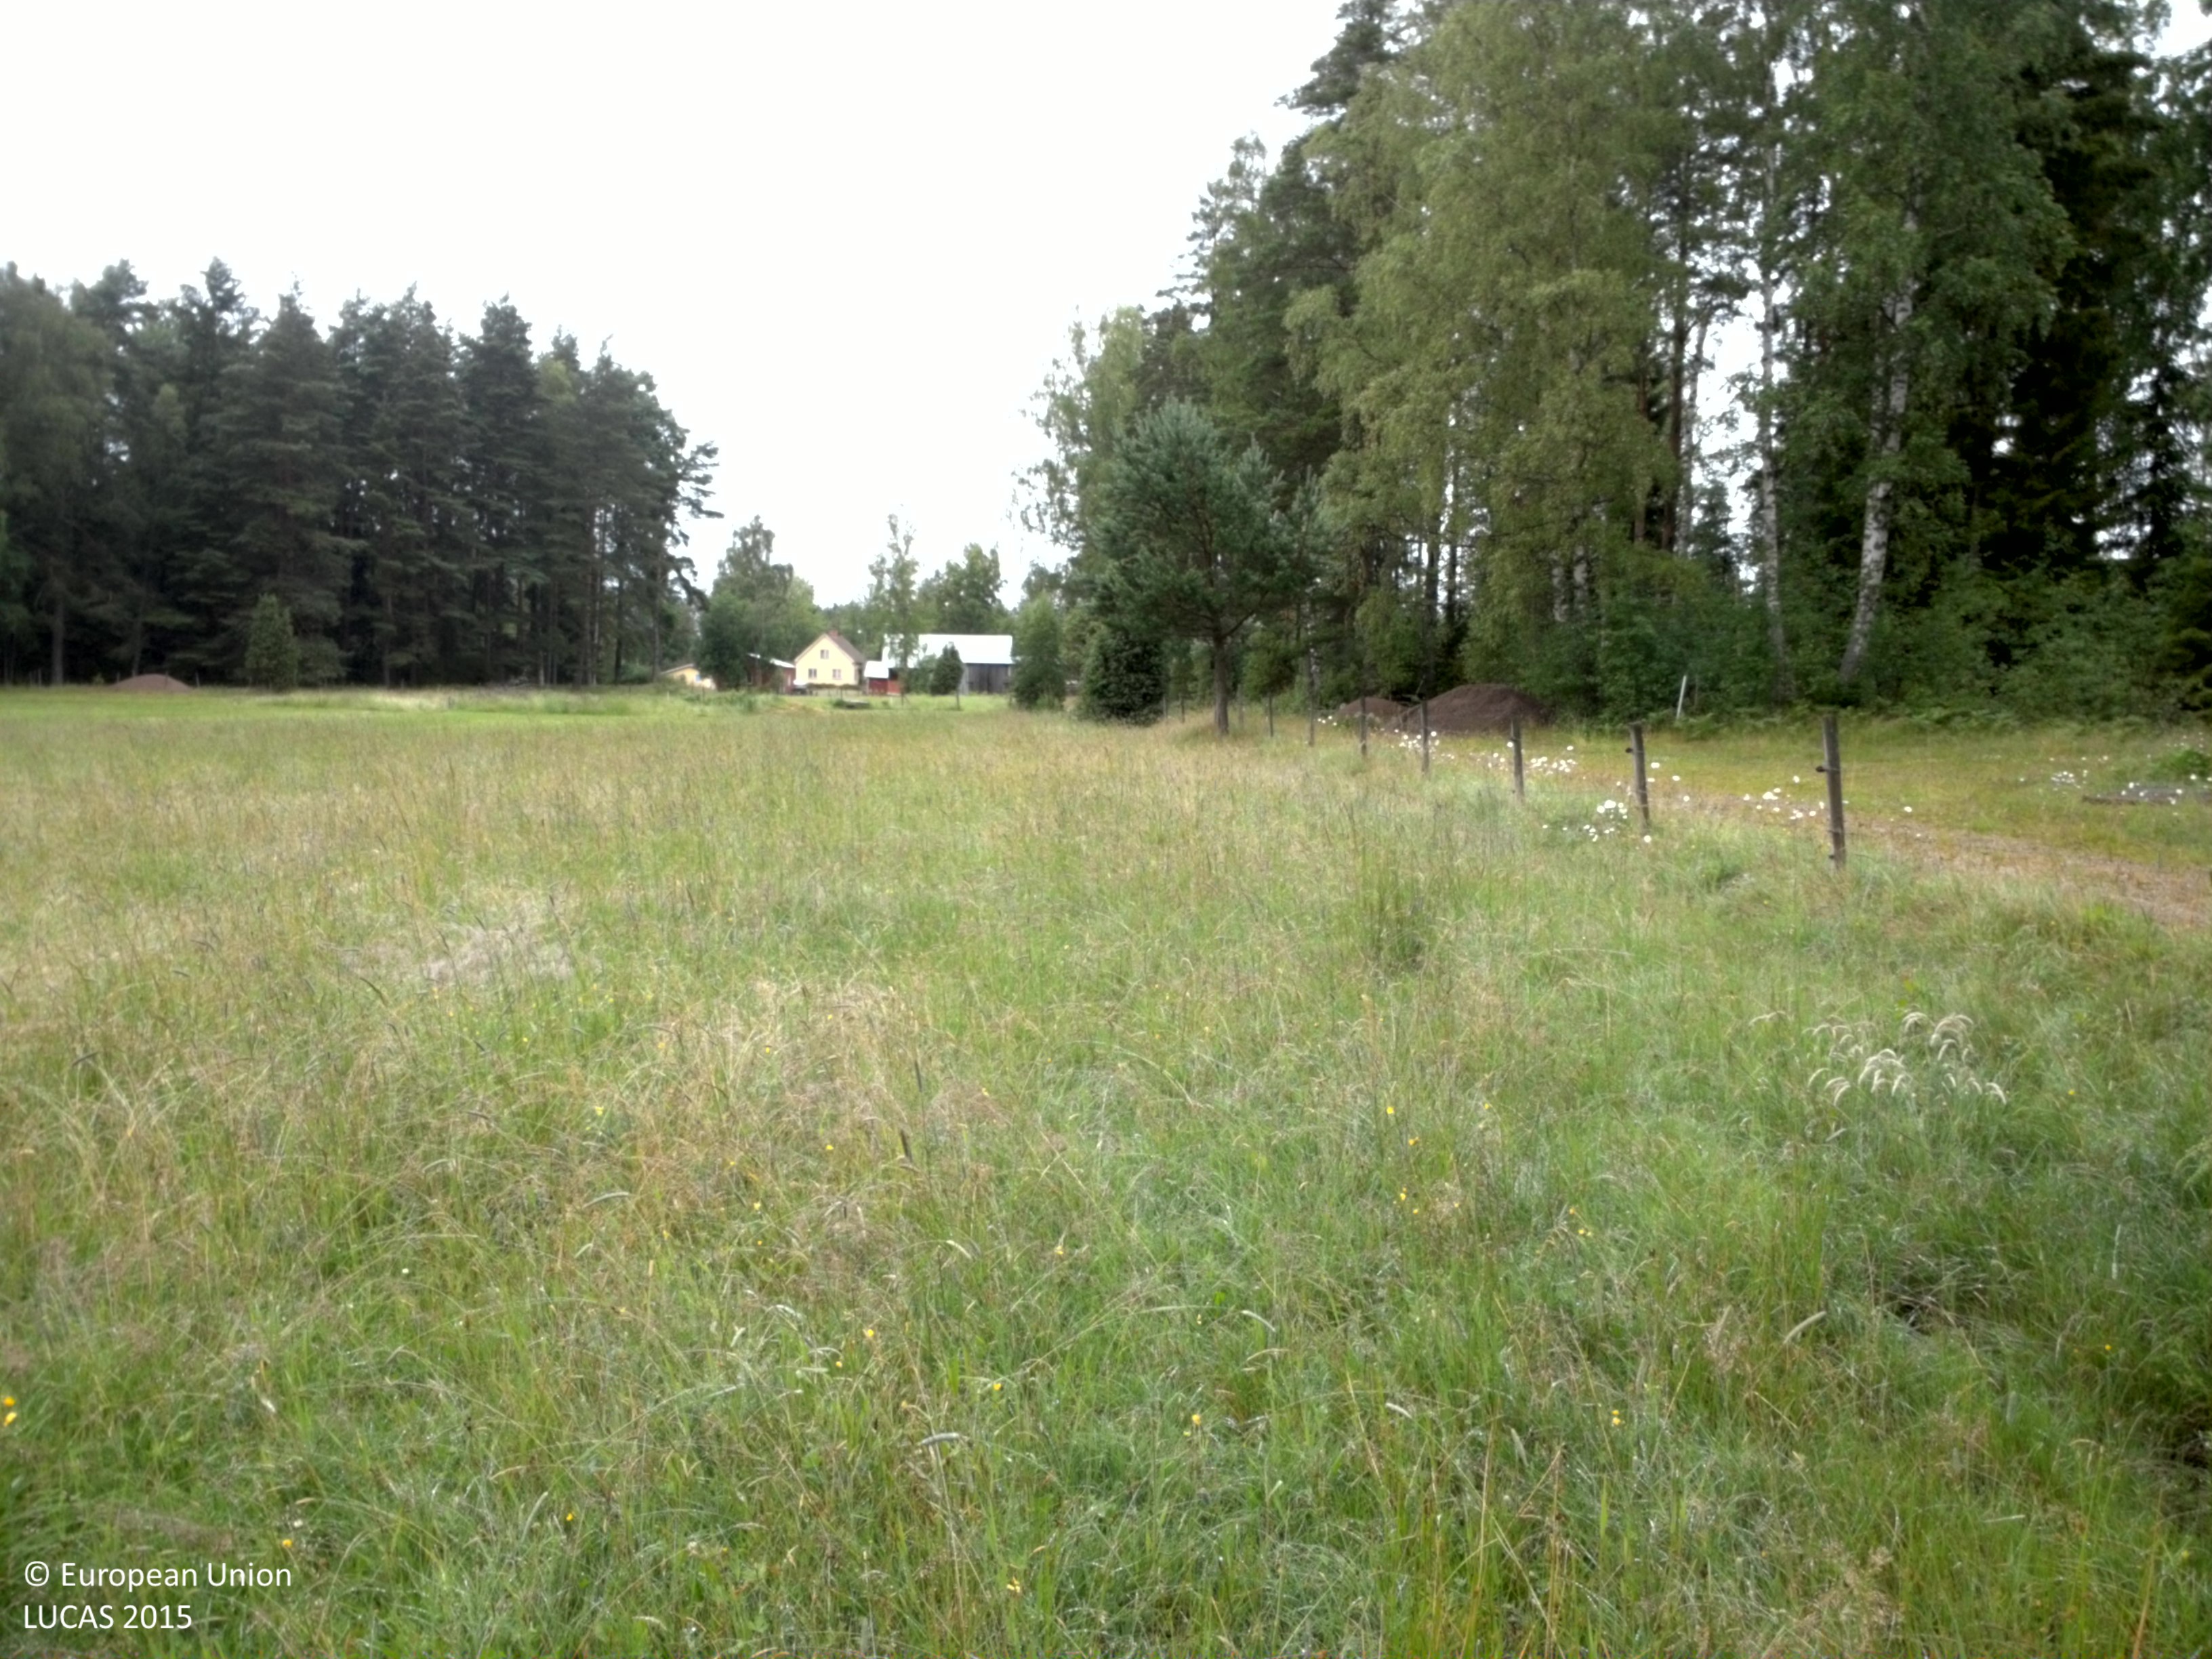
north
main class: Grassland
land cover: Grassland without tree/shrub cover
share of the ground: > 75 %
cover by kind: herbaceous plants 100 %
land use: Agriculture (excluding fallow land and kitchen gardens)
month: July
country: SE
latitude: 58.4656
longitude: 14.0221
